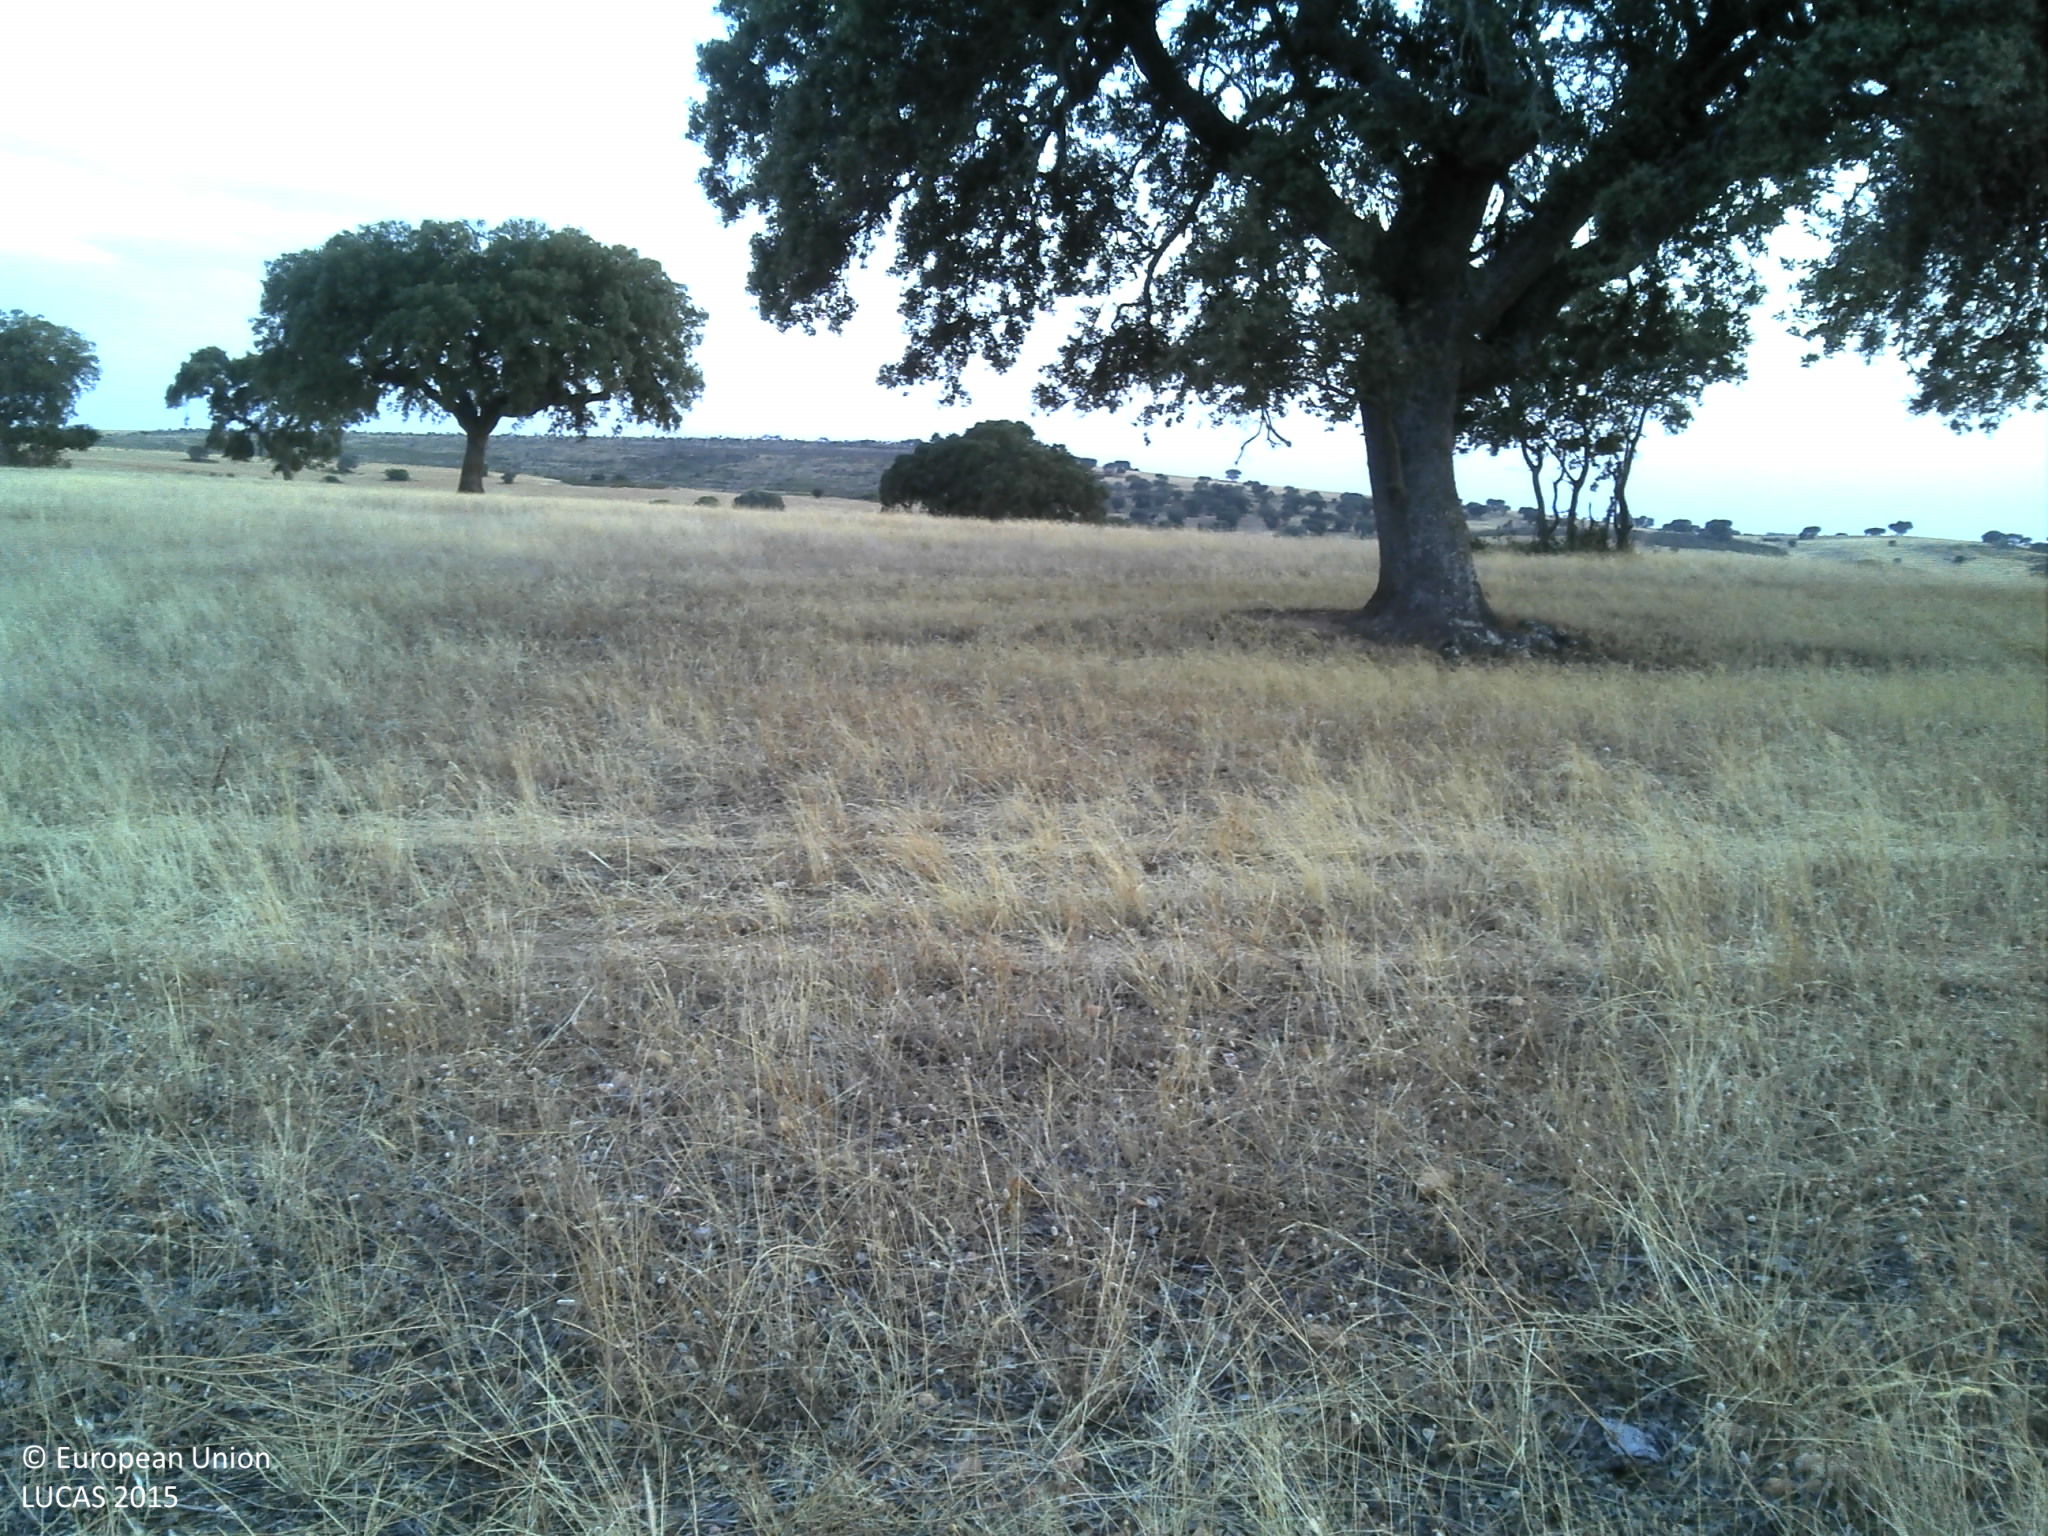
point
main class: Woodland
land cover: Broadleaved woodland
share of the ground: 25 - 50 %
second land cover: Grassland without tree/shrub cover
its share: 50 - 75 %
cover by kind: herbaceous plants 50 %, broadleaved forest trees 30 %, unconsolidated bare surface 20 %
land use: Forestry
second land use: Agriculture (excluding fallow land and kitchen gardens)
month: July
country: PT
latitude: 37.7730
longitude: -7.9048
